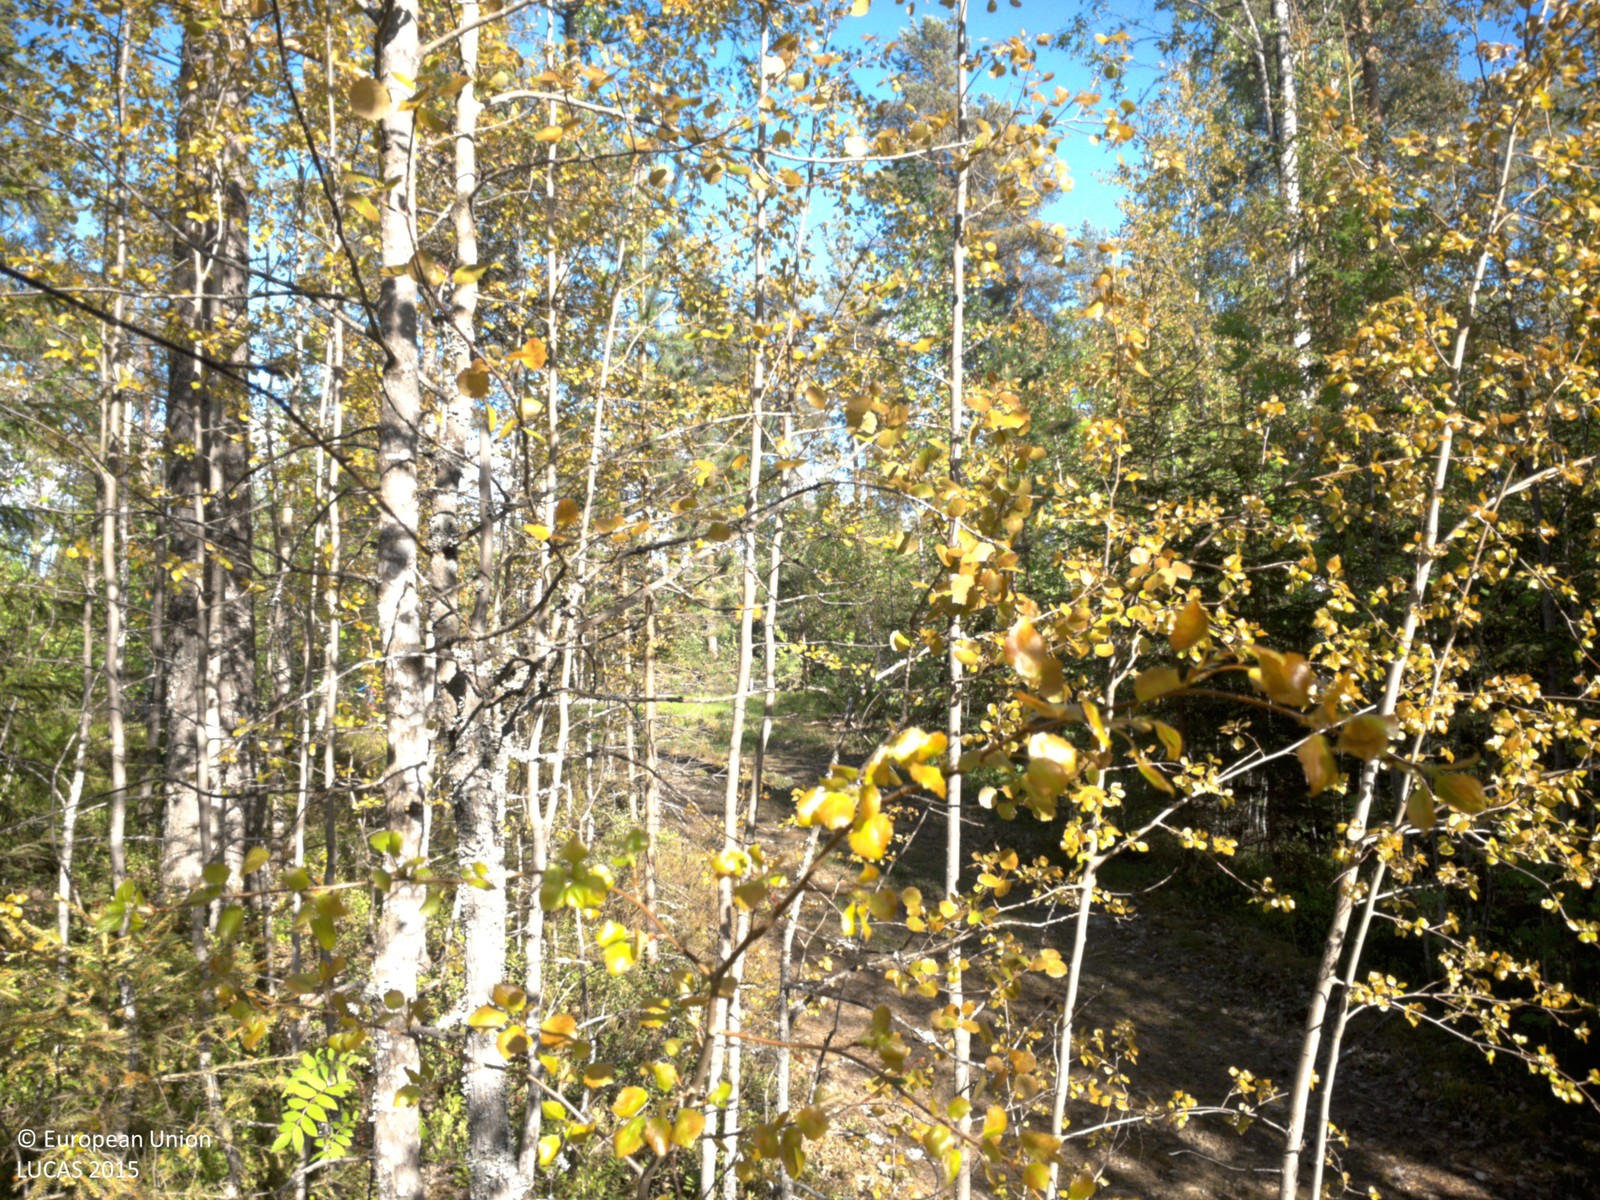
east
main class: Woodland
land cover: Other mixed woodland
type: boreal forest
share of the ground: 50 - 75 %
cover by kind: shrubs 45 %, coniferous forest trees 30 %, broadleaved forest trees 25 %
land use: Semi-natural and natural areas not in use
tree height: > 5 m
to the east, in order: Other mixed woodland; Paved roads, cycling and walking lanes; Tracks; Pine dominated mixed woodland; Broadleaved woodland; Grassland without tree/shrub cover; Other mixed woodland; Grassland without tree/shrub cover; Broadleaved woodland; Inland fresh water bodies
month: June
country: SE
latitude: 63.9847
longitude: 20.0945
